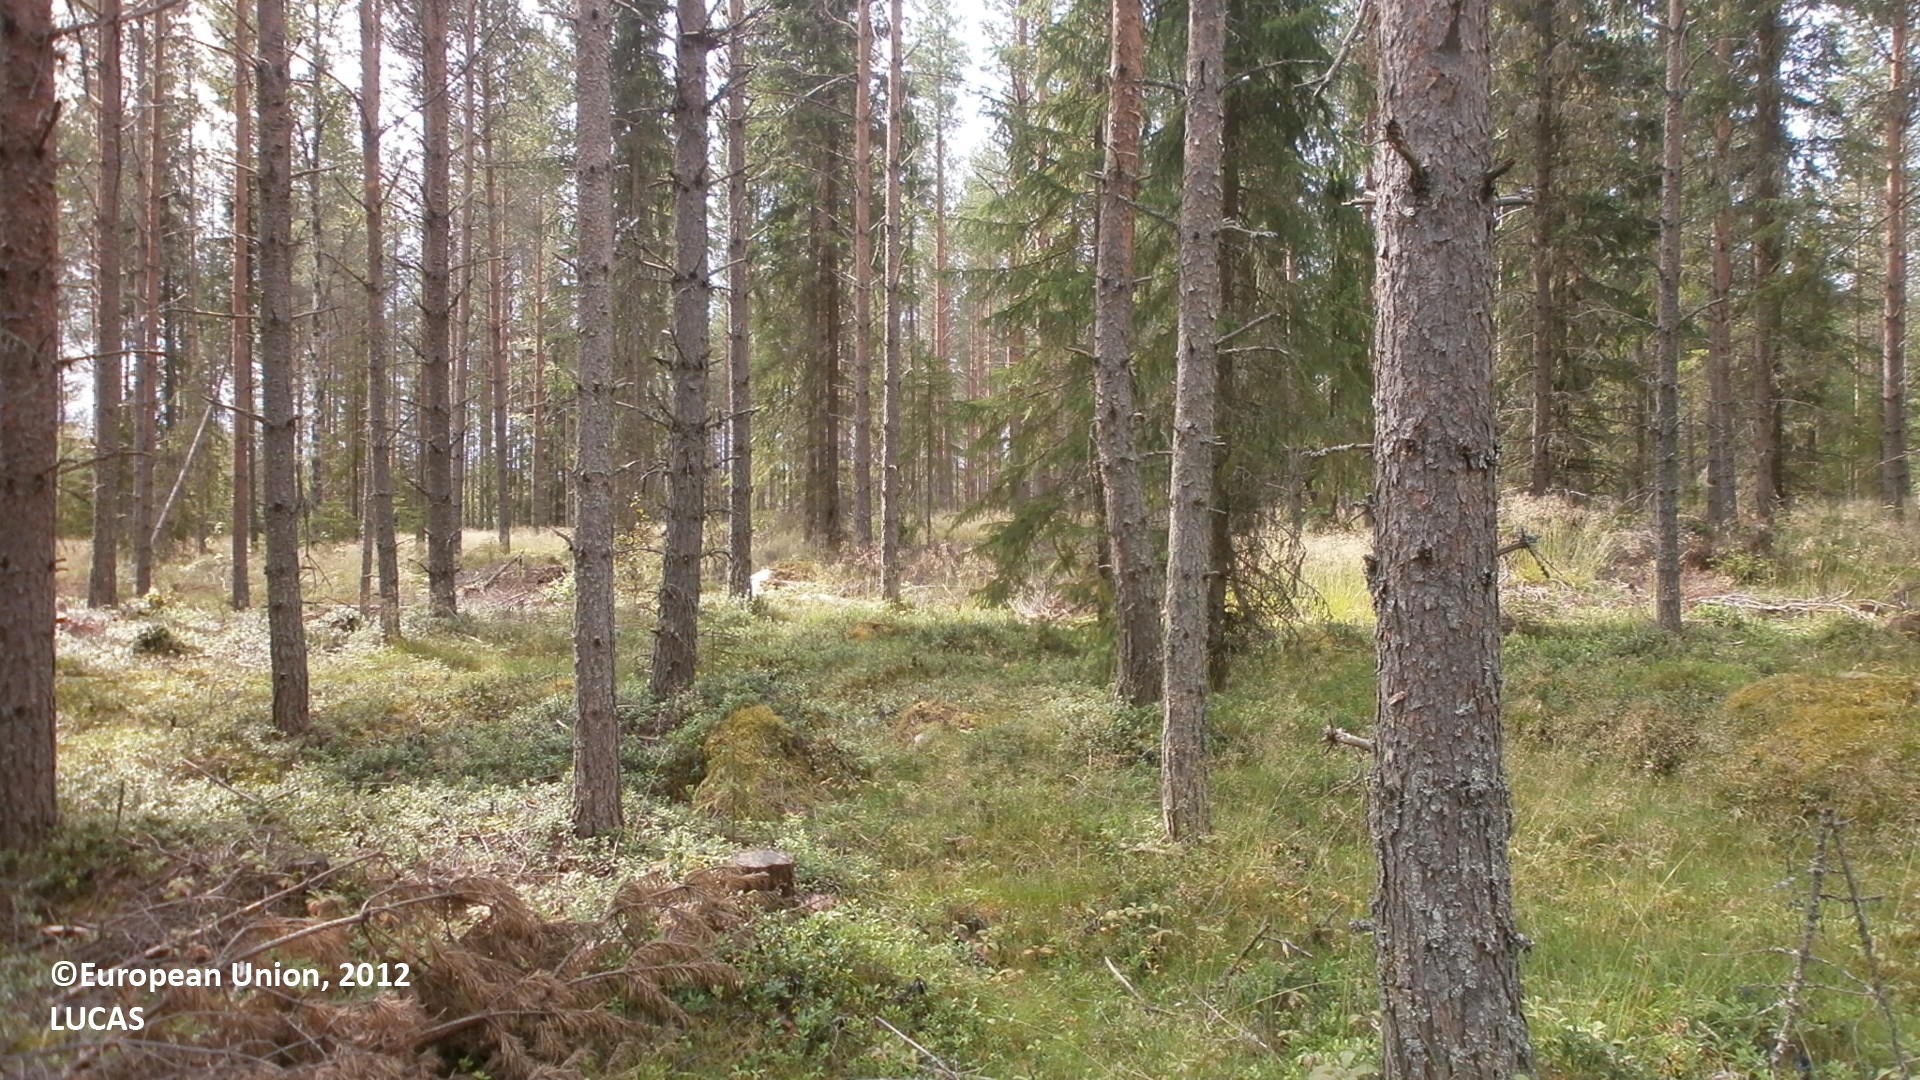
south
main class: Woodland
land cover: Pine dominated coniferous woodland
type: boreal forest
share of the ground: 50 - 75 %
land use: Forestry
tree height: > 5 m
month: July
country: FI
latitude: 64.0592
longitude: 23.8931
